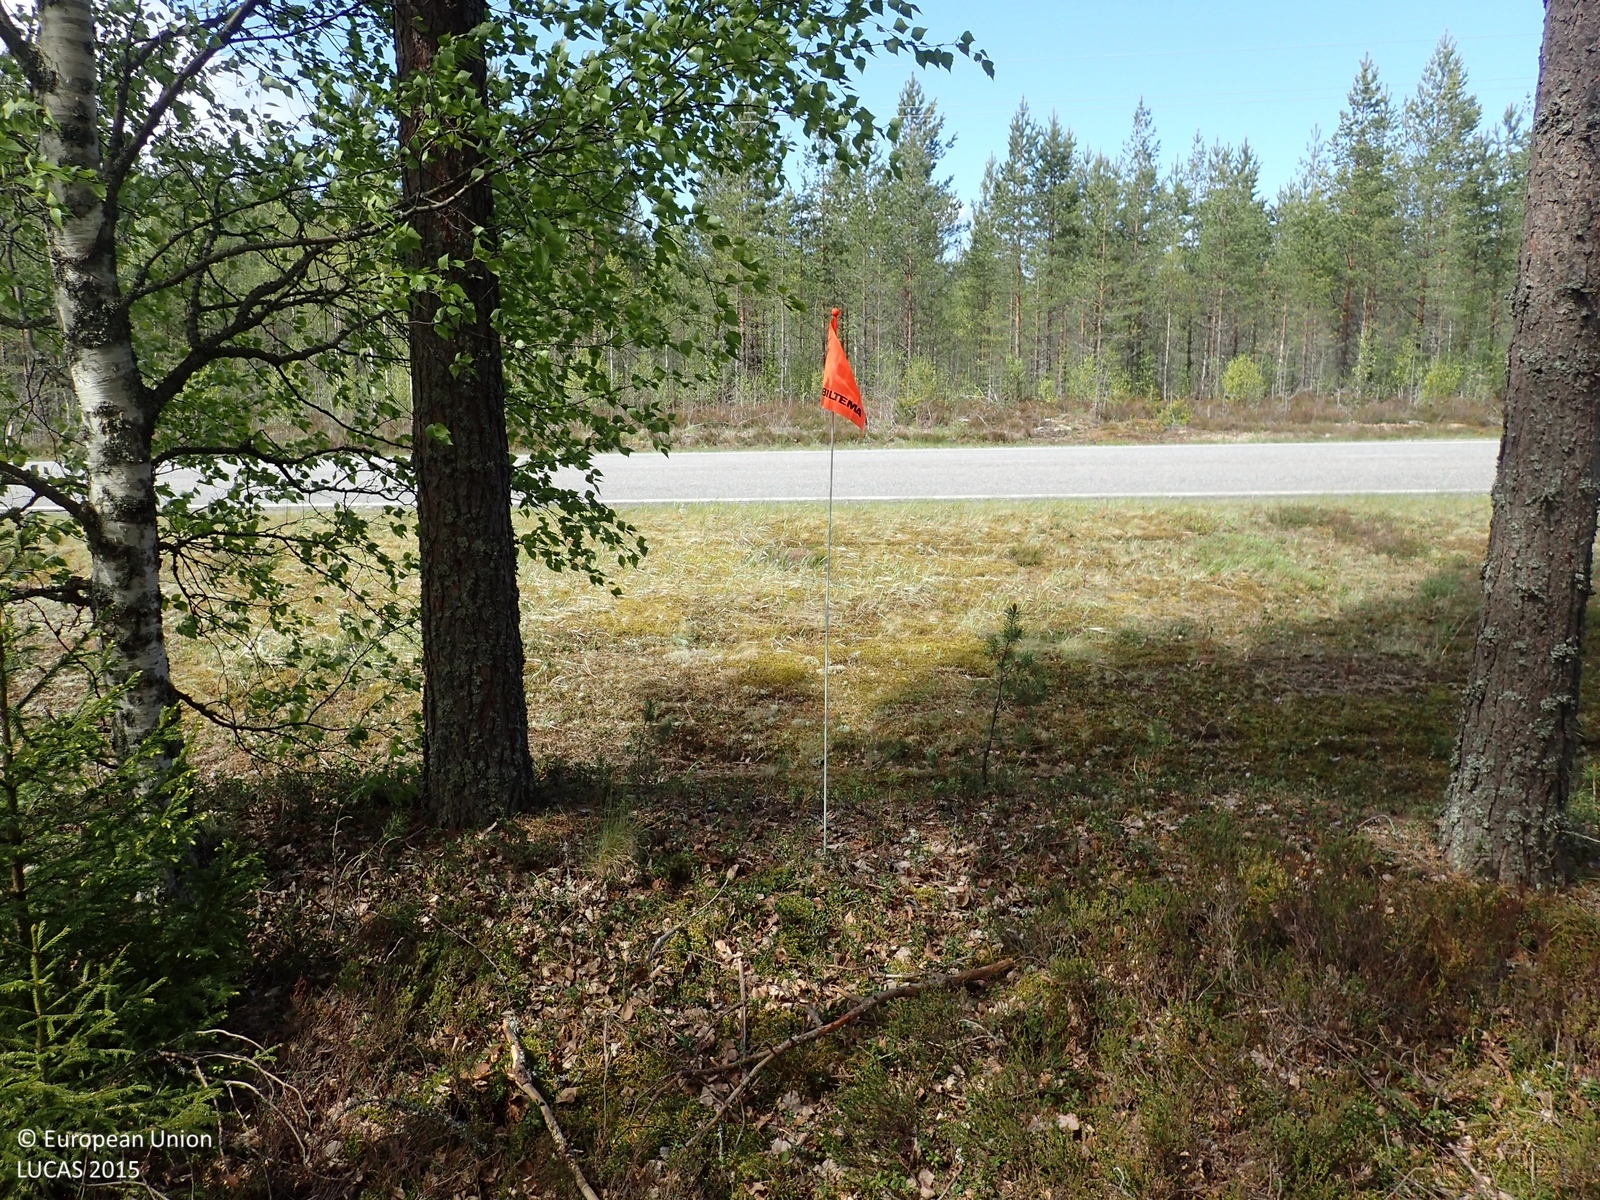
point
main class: Woodland
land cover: Pine dominated coniferous woodland
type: boreal forest
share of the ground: > 75 %
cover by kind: coniferous forest trees 65 %, shrubs 20 %, broadleaved forest trees 10 %, lichens and mosses 5 %
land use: Forestry
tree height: > 5 m
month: June
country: FI
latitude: 62.1798
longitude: 22.2903
